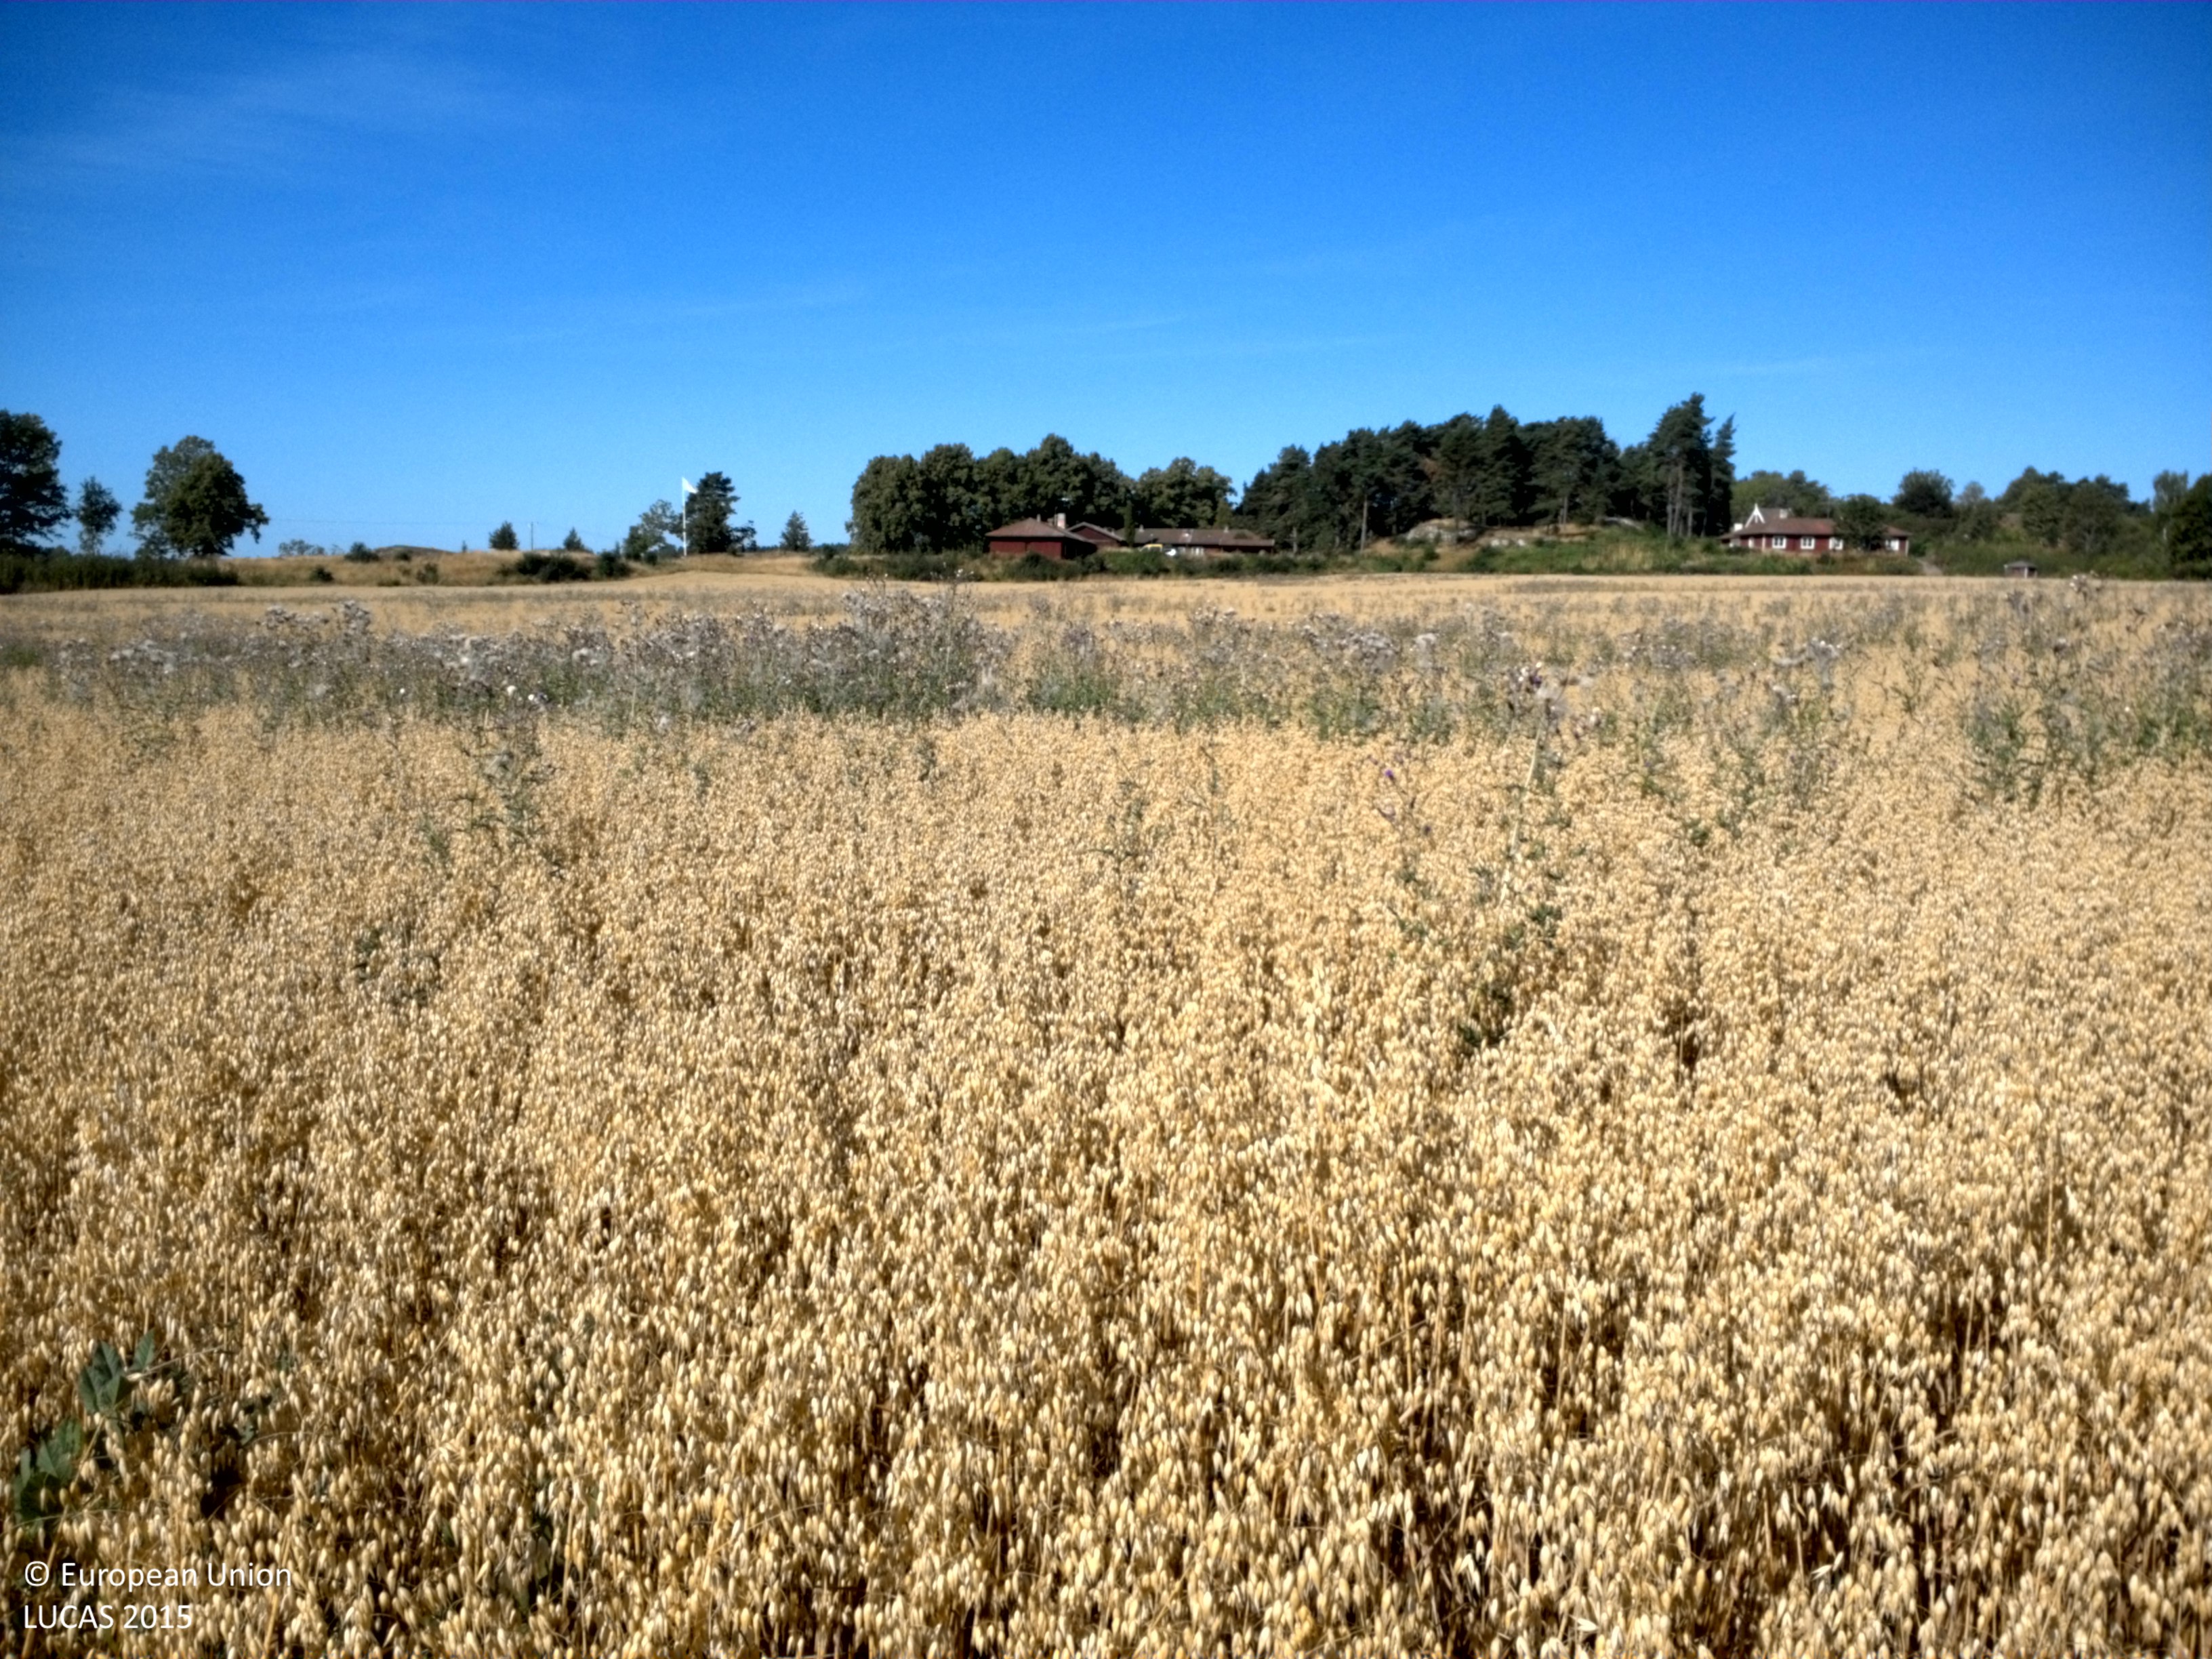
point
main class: Cropland
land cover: Oats
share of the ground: > 75 %
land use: Agriculture (excluding fallow land and kitchen gardens)
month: August
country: SE
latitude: 59.5066
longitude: 17.5752
